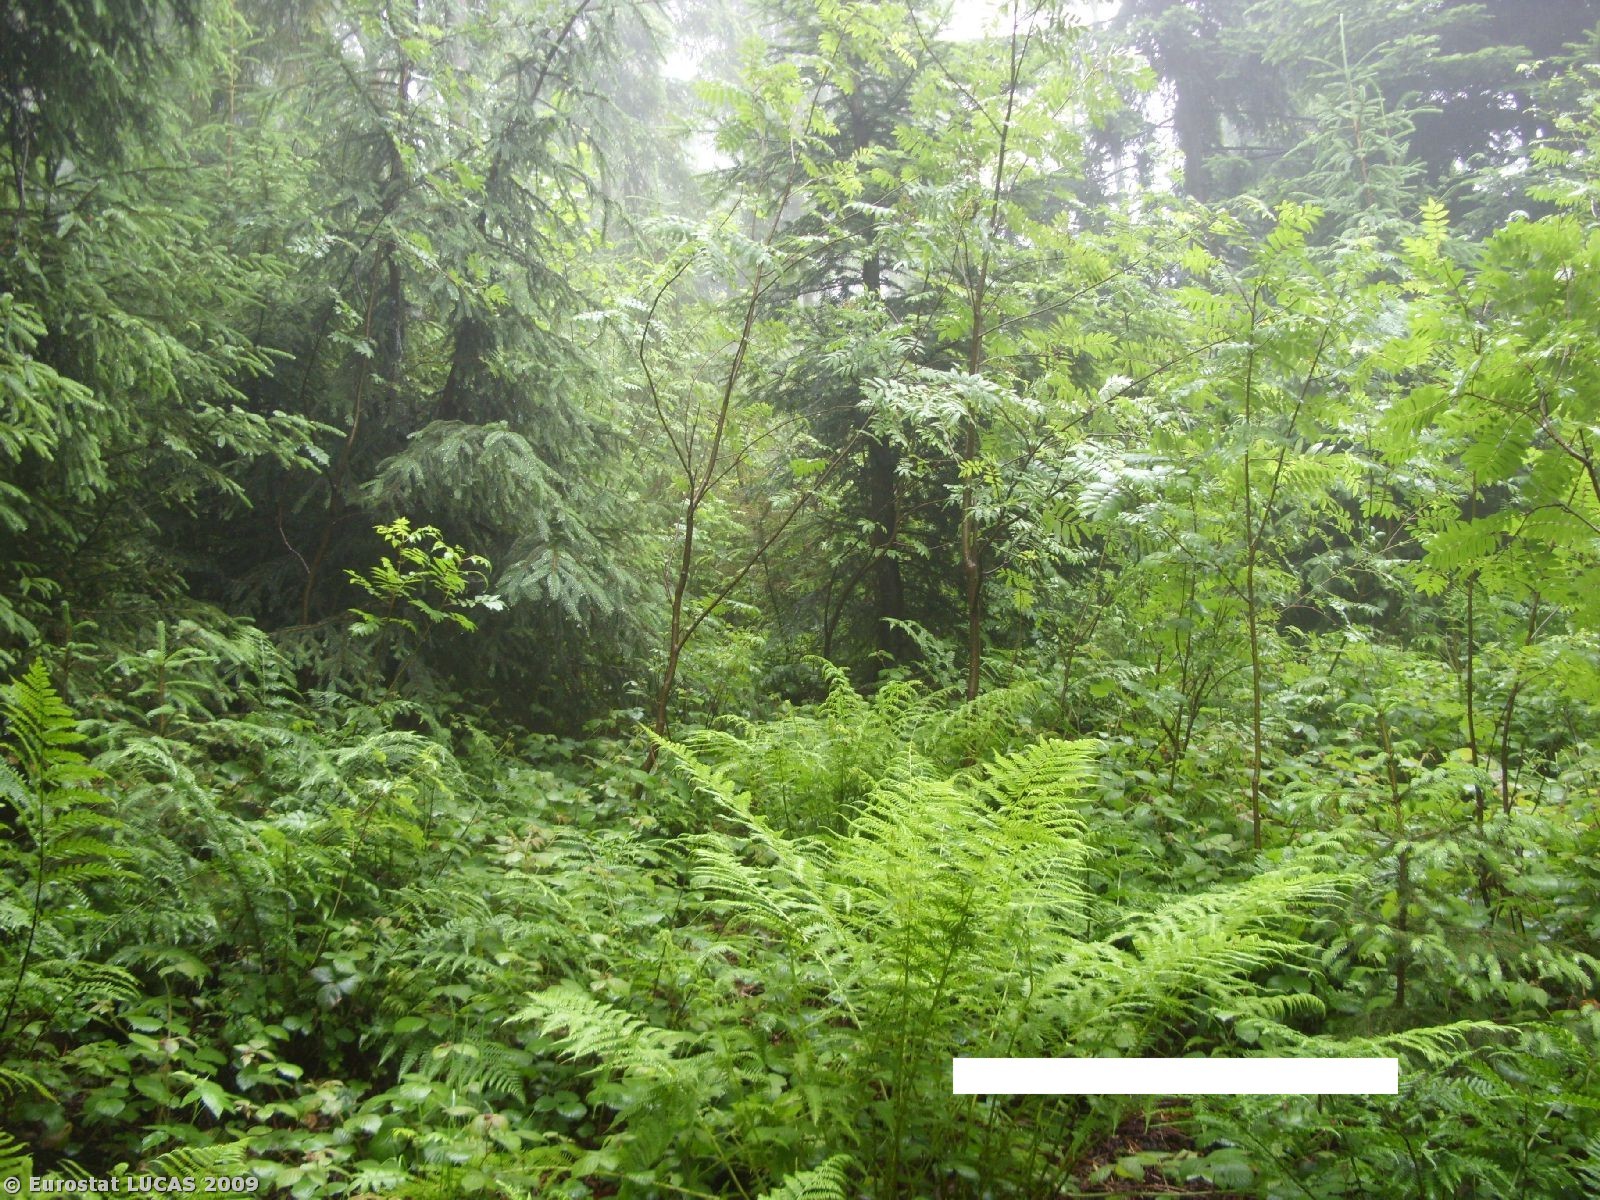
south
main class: Woodland
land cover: Mixed woodland
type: hemiboreal forest and nemoral coniferous forest and mixed broadleaved-coniferous forest
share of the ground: > 75 %
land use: Forestry
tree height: > 5 m
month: June
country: PL
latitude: 49.6610
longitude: 19.9085
